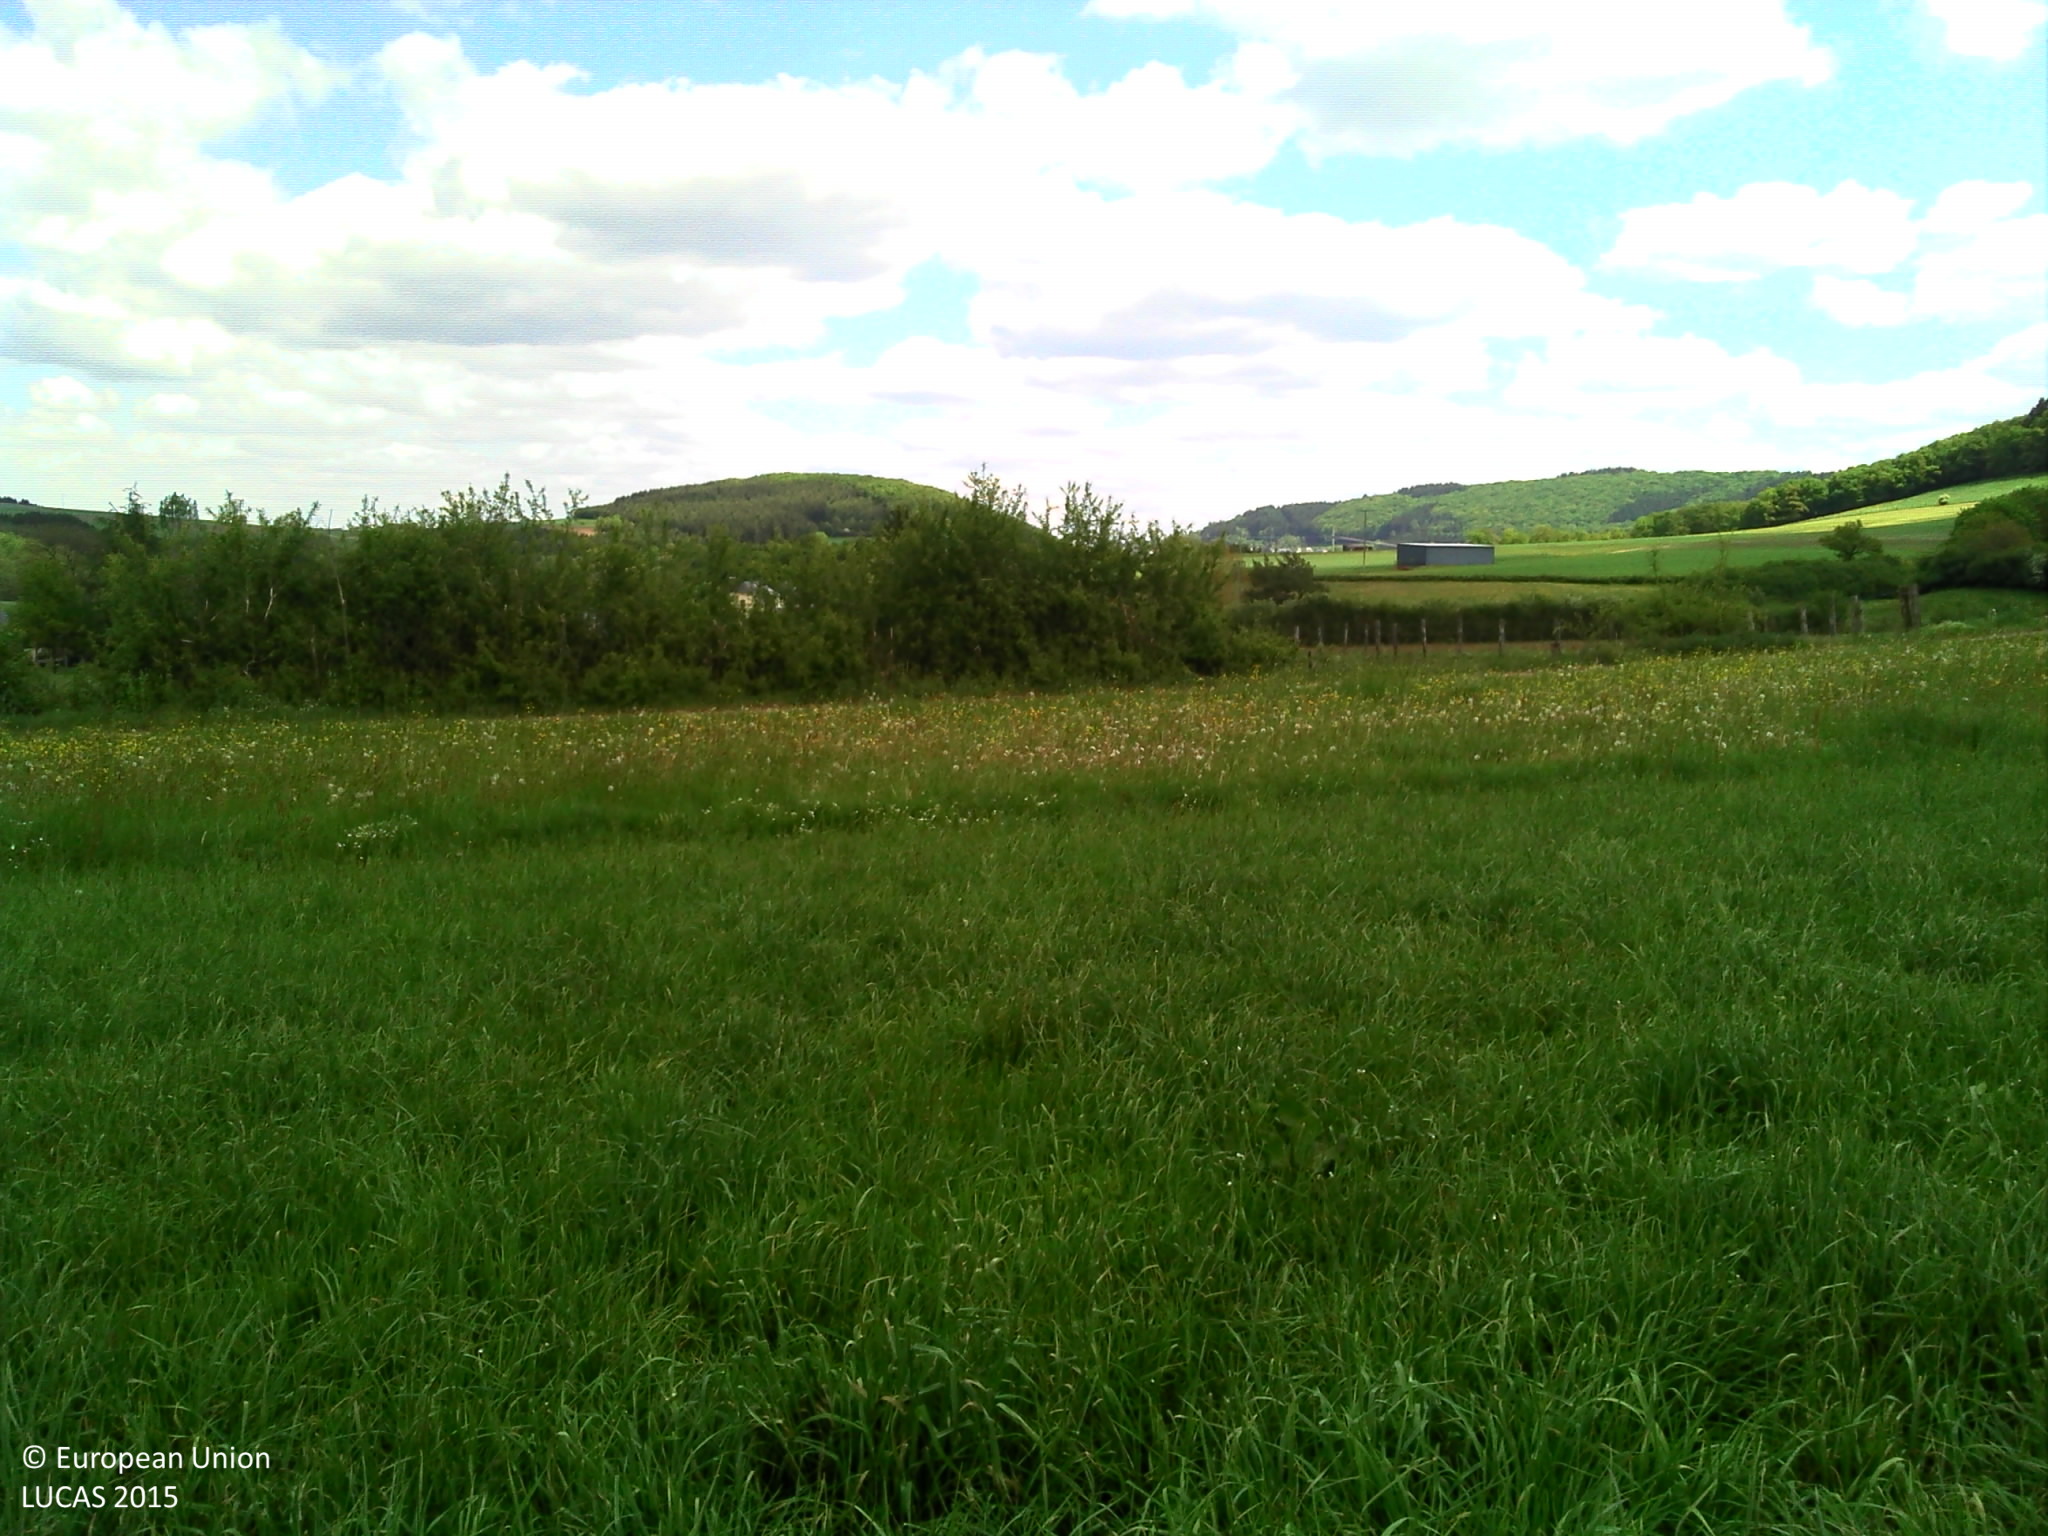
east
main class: Grassland
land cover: Grassland without tree/shrub cover
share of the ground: > 75 %
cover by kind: herbaceous plants 100 %
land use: Agriculture (excluding fallow land and kitchen gardens)
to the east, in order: Grassland without tree/shrub cover; Tracks; Fences; Grassland without tree/shrub cover; Fences; Grassland without tree/shrub cover; Fences; Managed hedges; Grassland without tree/shrub cover
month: May
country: LU
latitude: 49.9660
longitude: 5.8863
